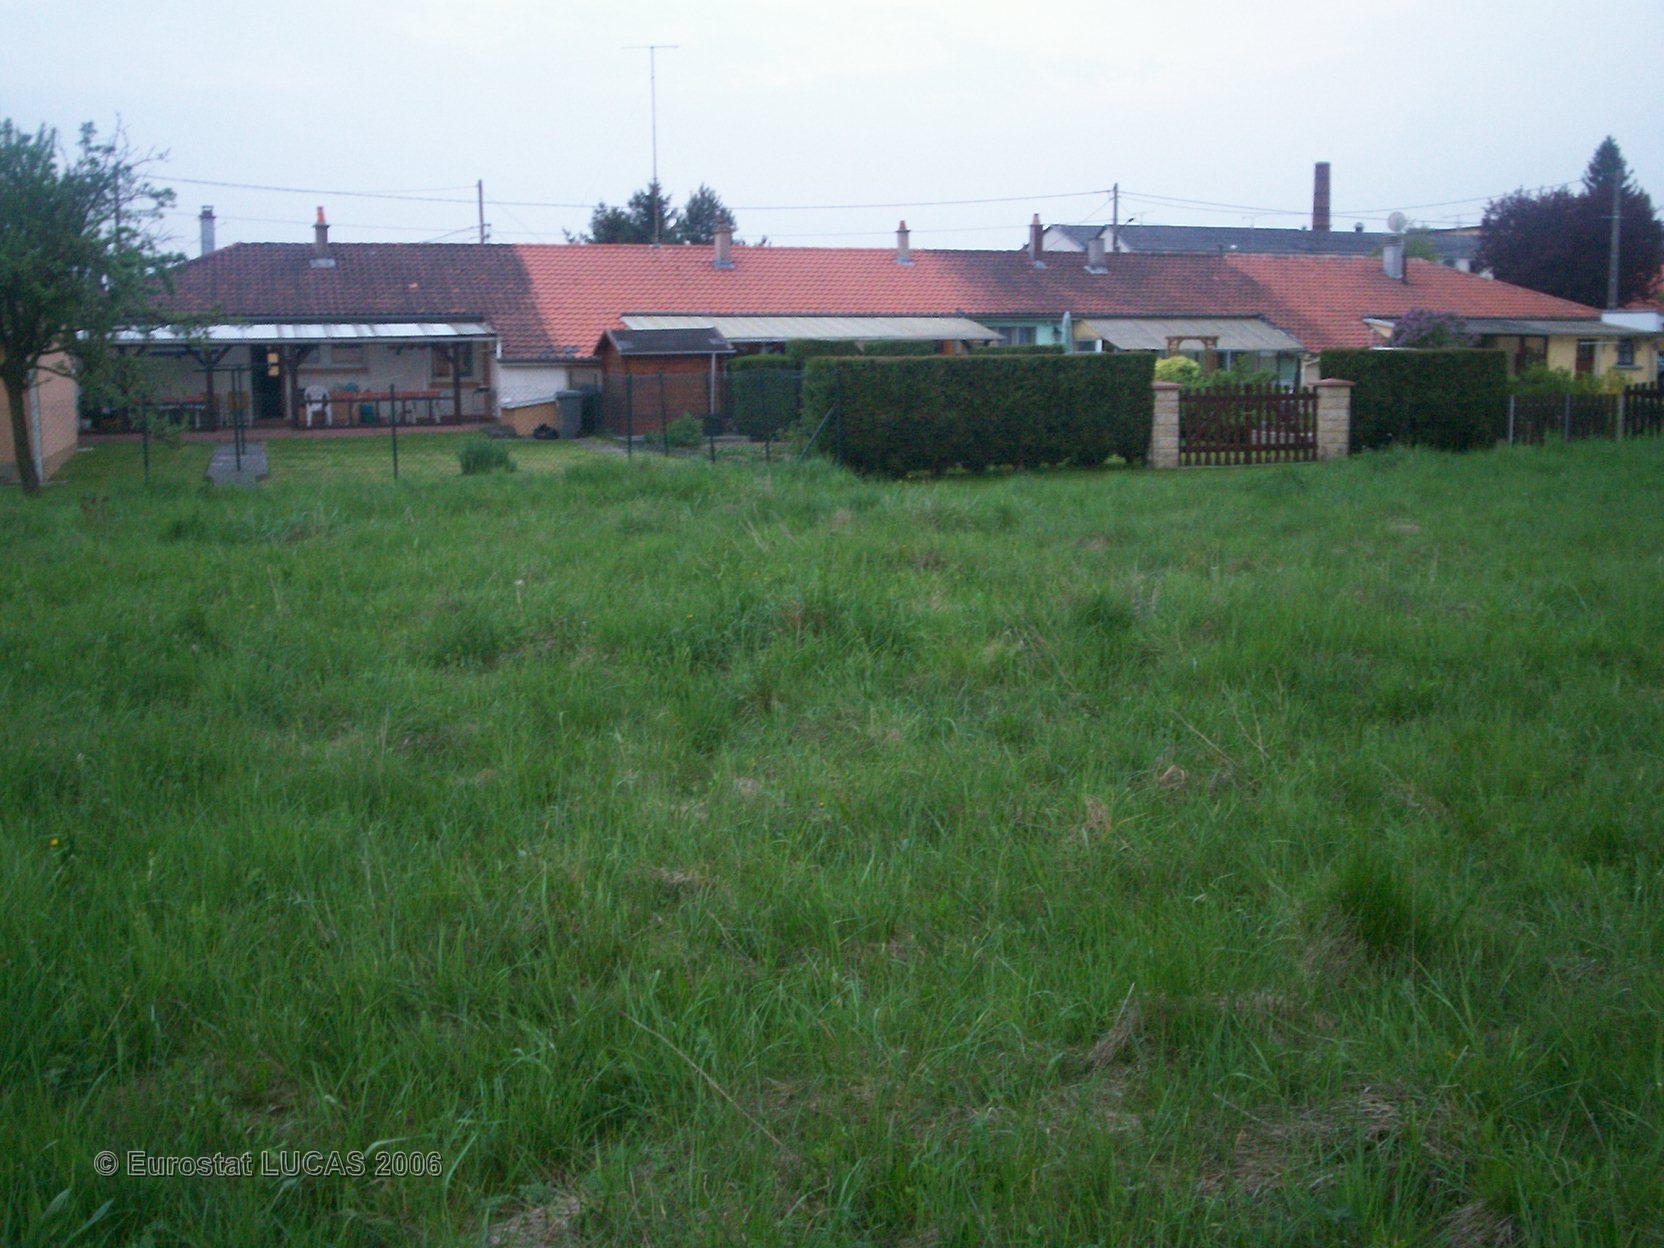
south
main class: Grassland
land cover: Grassland without tree/shrub cover
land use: Agriculture (excluding fallow land and kitchen gardens)
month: May
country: FR
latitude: 48.7430
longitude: 7.0768
